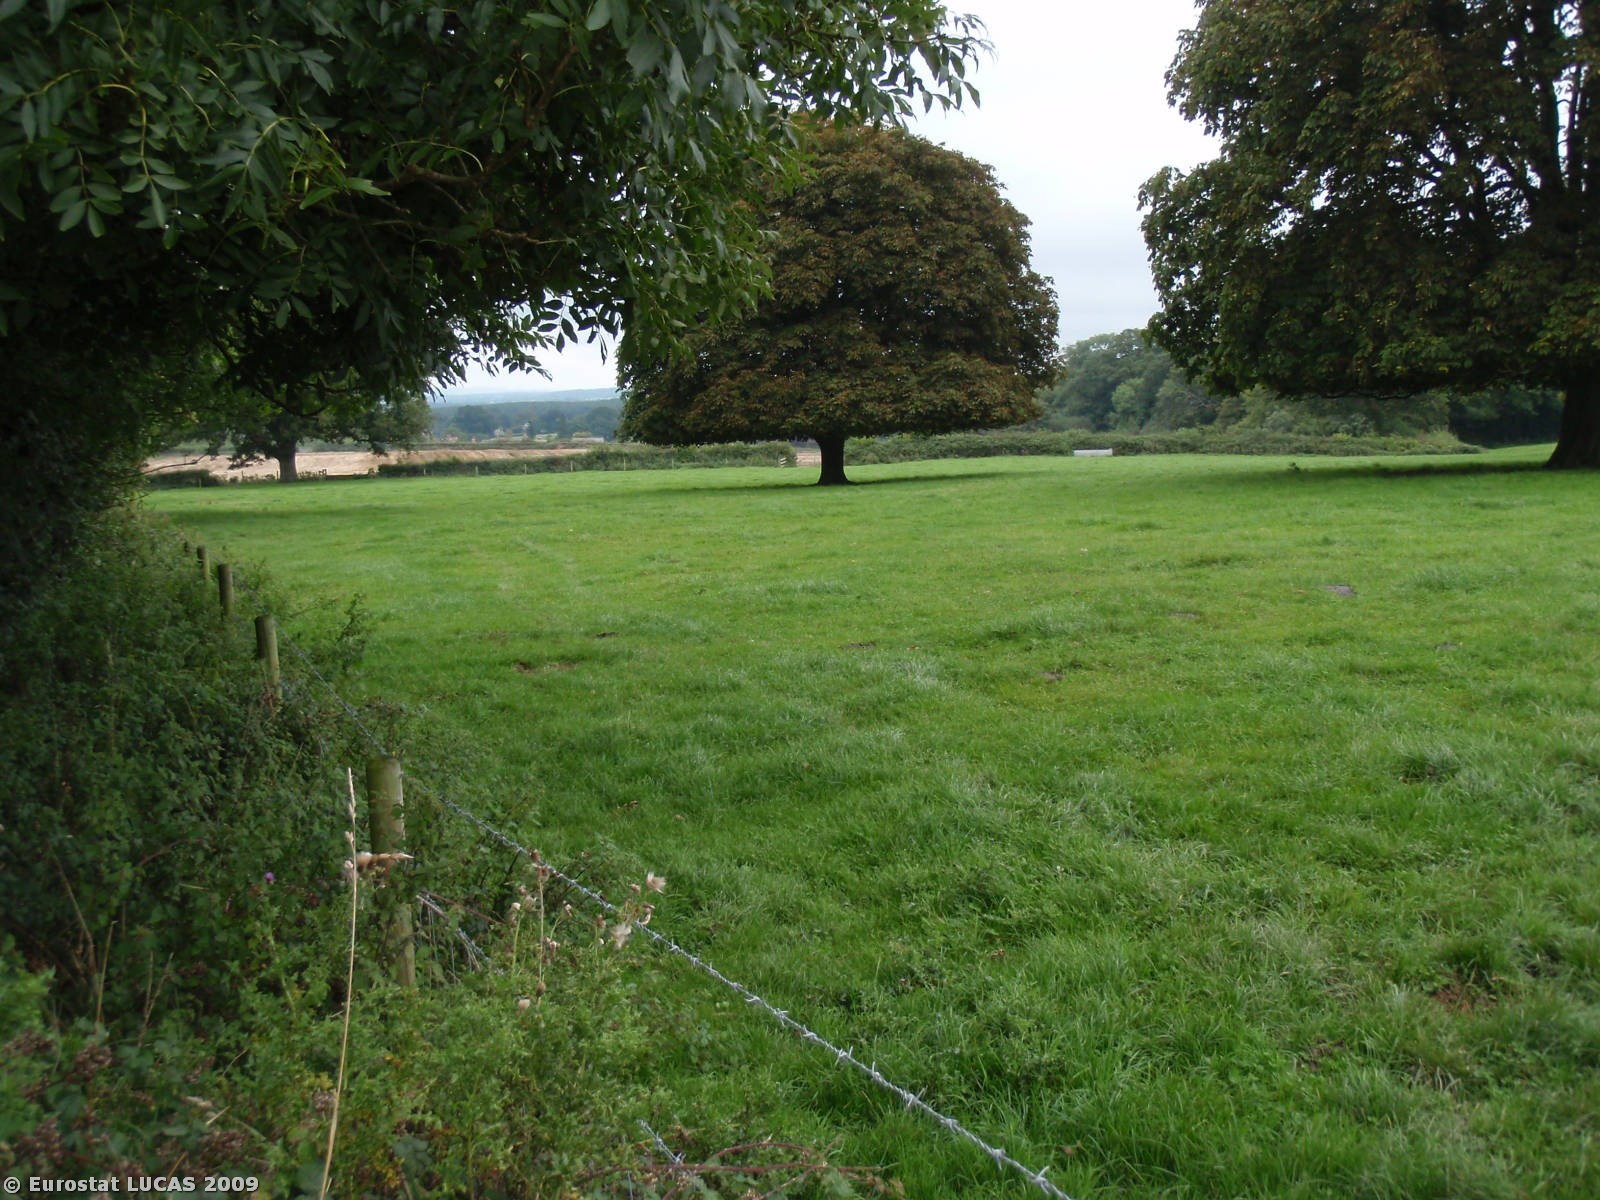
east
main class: Grassland
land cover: Grassland without tree/shrub cover
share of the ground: > 75 %
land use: Agriculture (excluding fallow land and kitchen gardens)
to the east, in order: Grassland without tree/shrub cover; Broadleaved woodland; Coniferous woodland
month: September
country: GB
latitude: 50.8638
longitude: -2.6138
